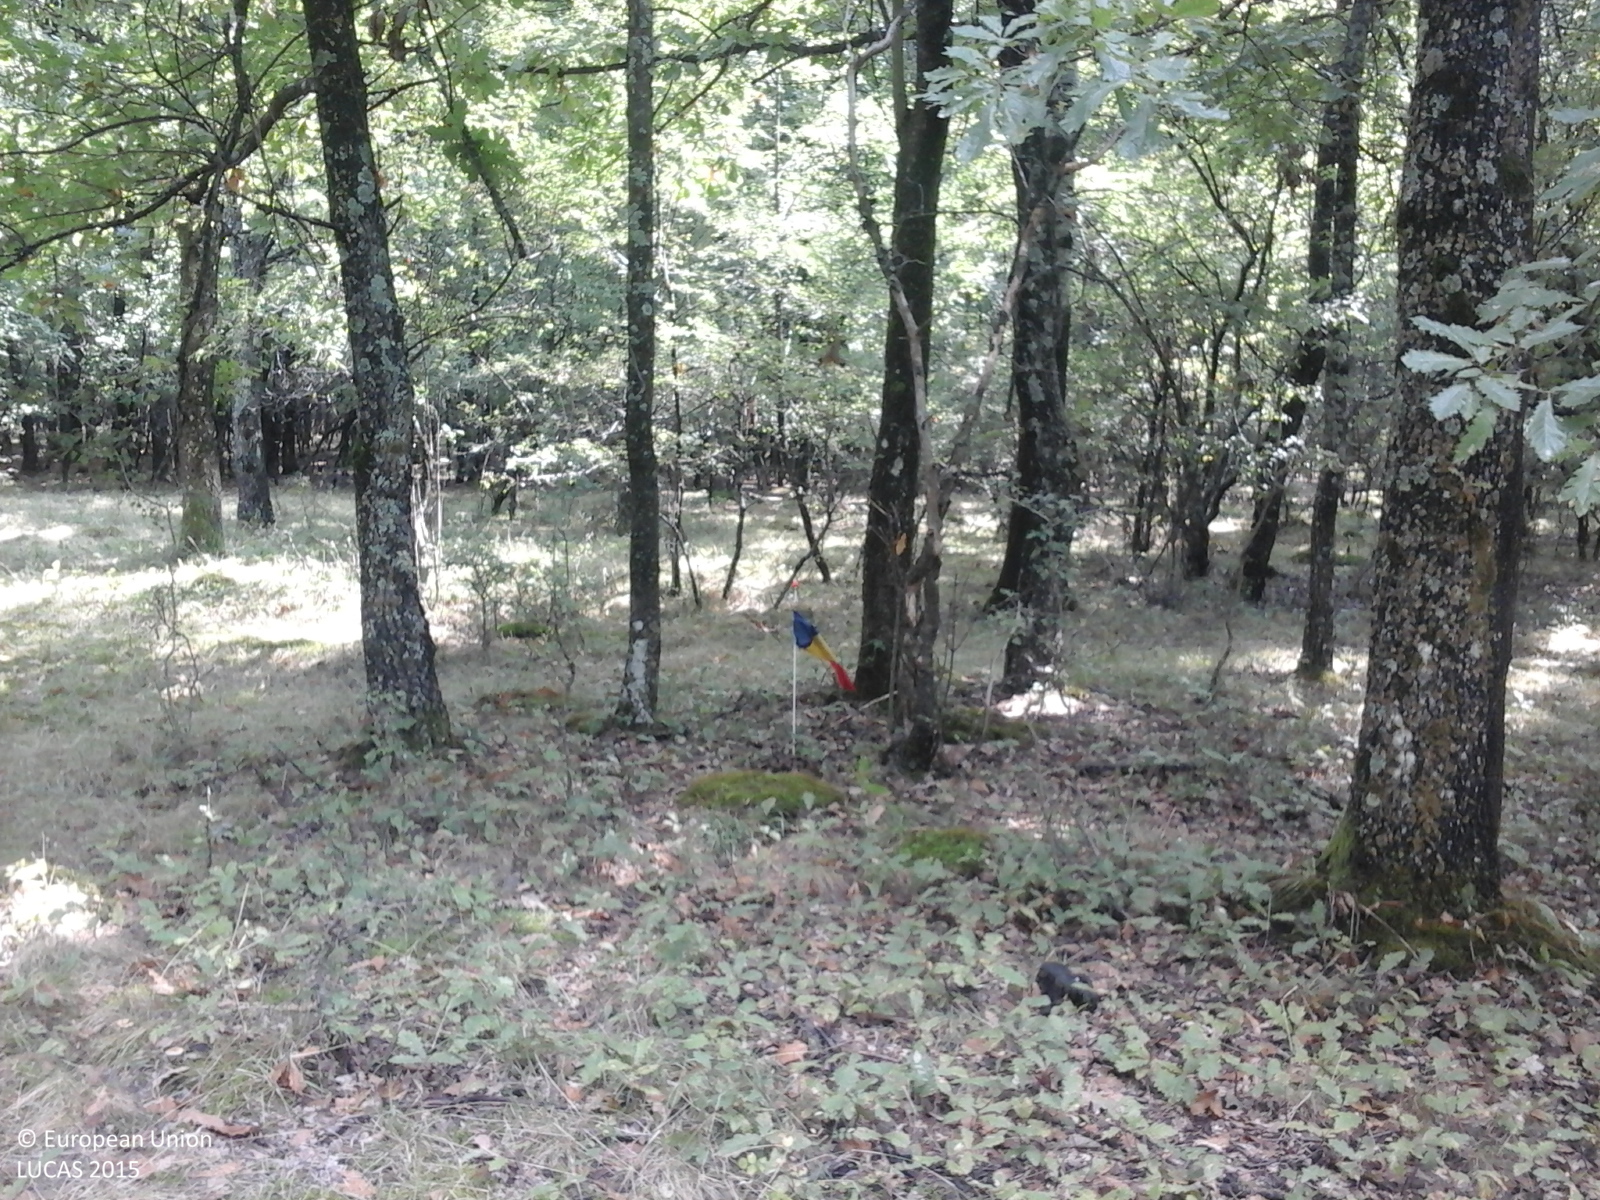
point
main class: Woodland
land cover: Broadleaved woodland
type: acidophilous oak and oak-birch forest
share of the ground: > 75 %
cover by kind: broadleaved forest trees 100 %
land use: Forestry
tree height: > 5 m
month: September
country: RO
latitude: 45.0855
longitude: 23.0993
